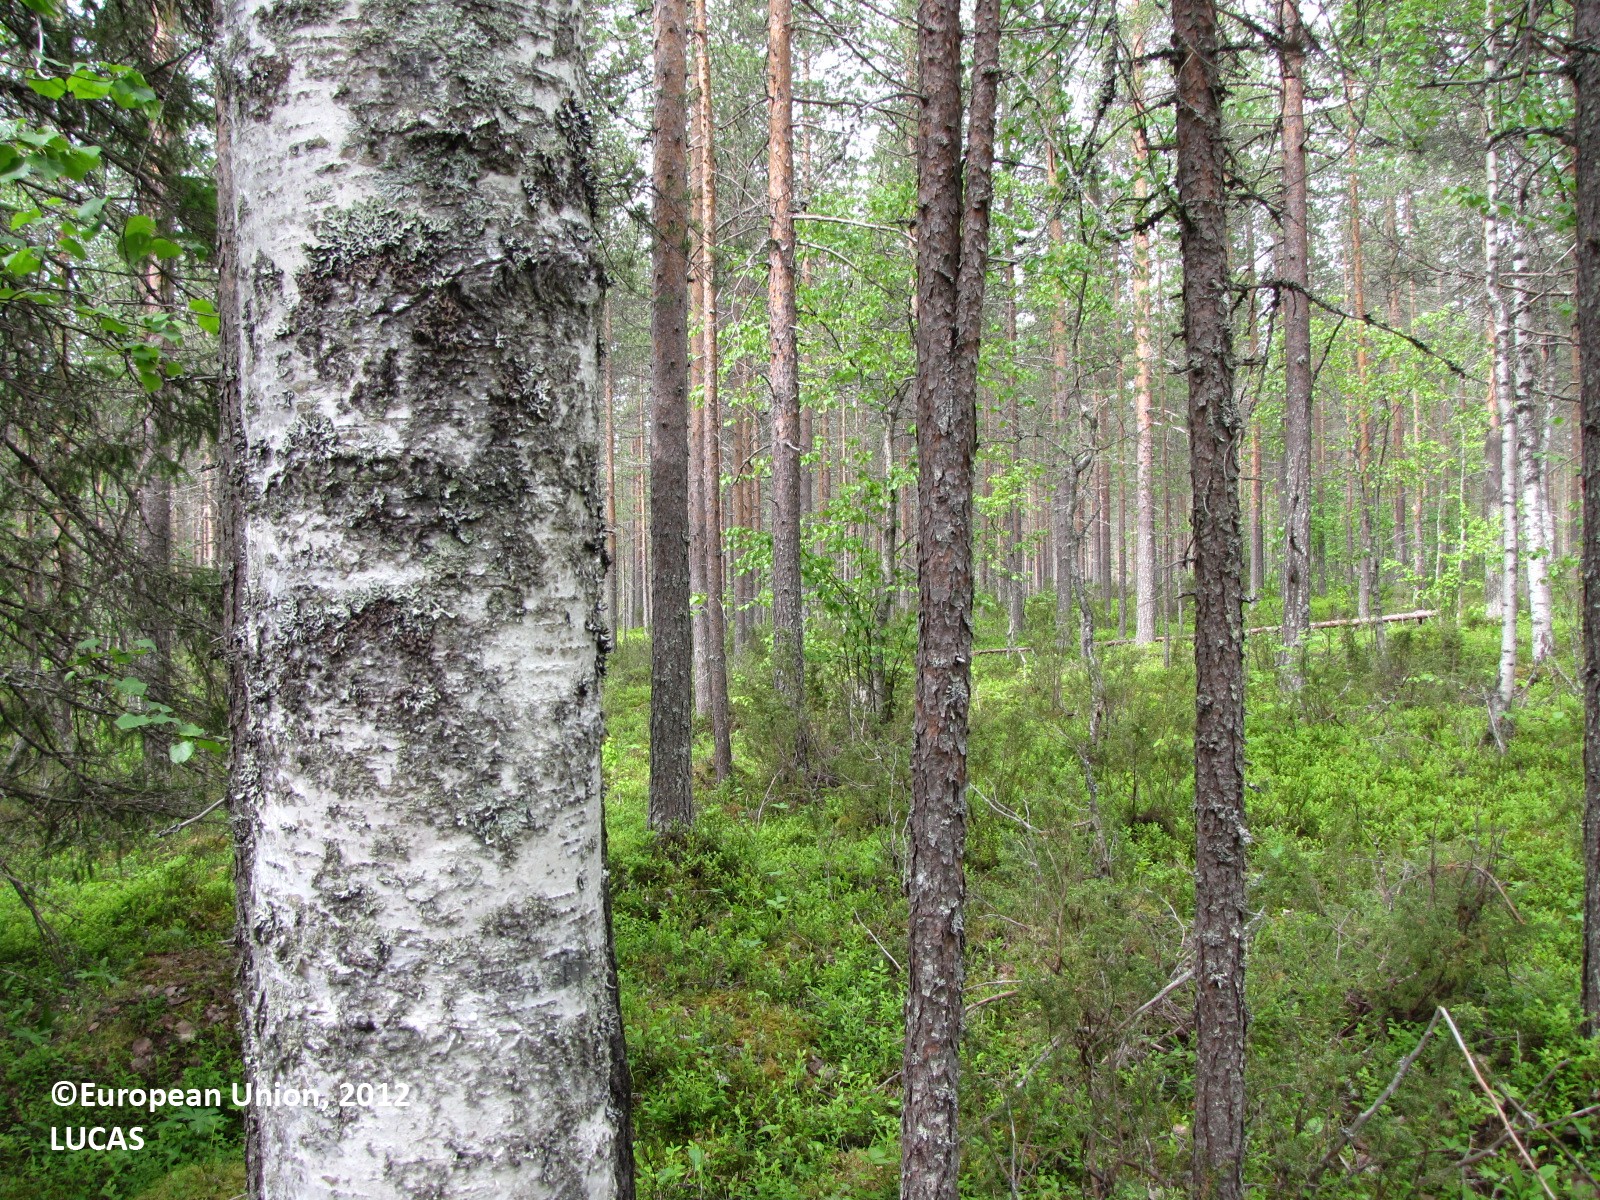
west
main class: Woodland
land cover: Pine dominated mixed woodland
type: boreal forest
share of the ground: 10 - 25 %
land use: Forestry
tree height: > 5 m
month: June
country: FI
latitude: 66.2318
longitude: 24.9768
